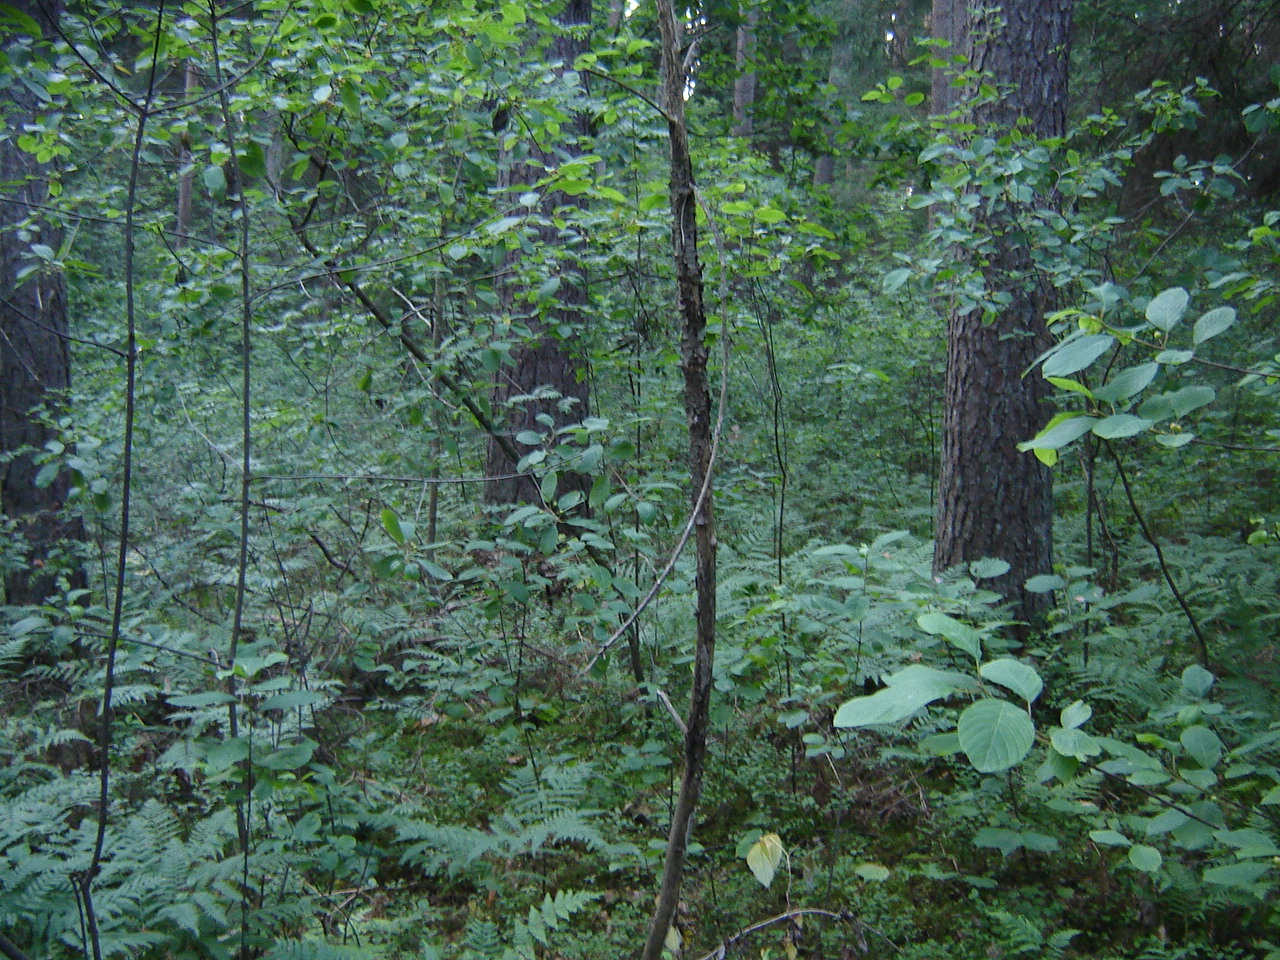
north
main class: Woodland
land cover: Pine dominated coniferous woodland
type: hemiboreal forest and nemoral coniferous forest and mixed broadleaved-coniferous forest
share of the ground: > 75 %
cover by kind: coniferous forest trees 80 %, broadleaved forest trees 10 %, herbaceous plants 5 %, lichens and mosses 5 %
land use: Forestry
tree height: > 5 m
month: July
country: LT
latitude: 55.5093
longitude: 25.0772
